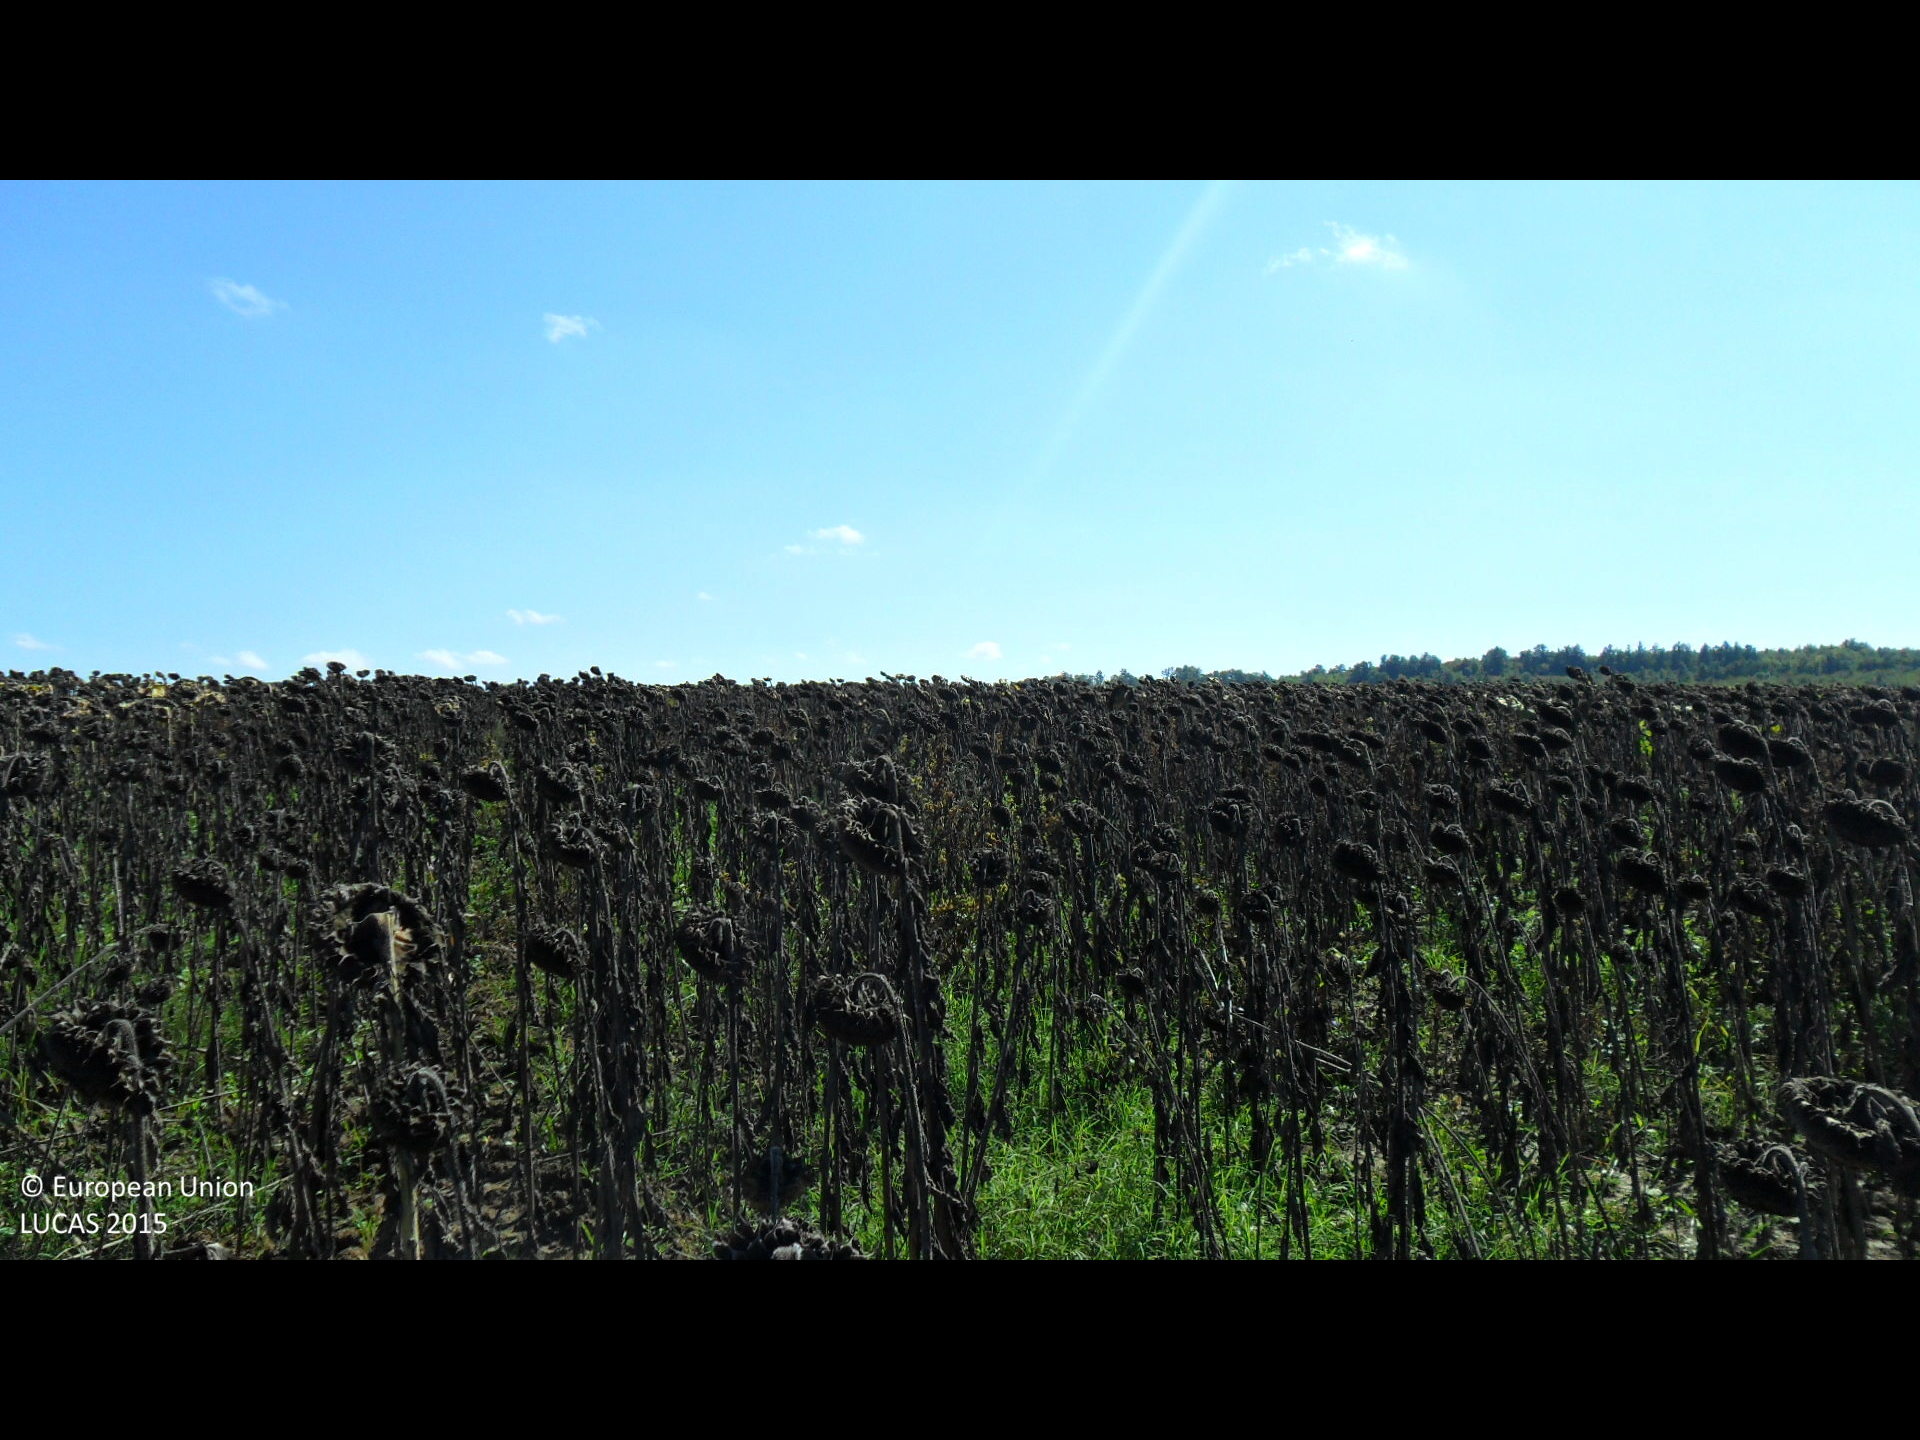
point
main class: Cropland
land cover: Sunflower
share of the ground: > 75 %
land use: Agriculture (excluding fallow land and kitchen gardens)
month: October
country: BG
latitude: 43.1351
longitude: 26.2356
